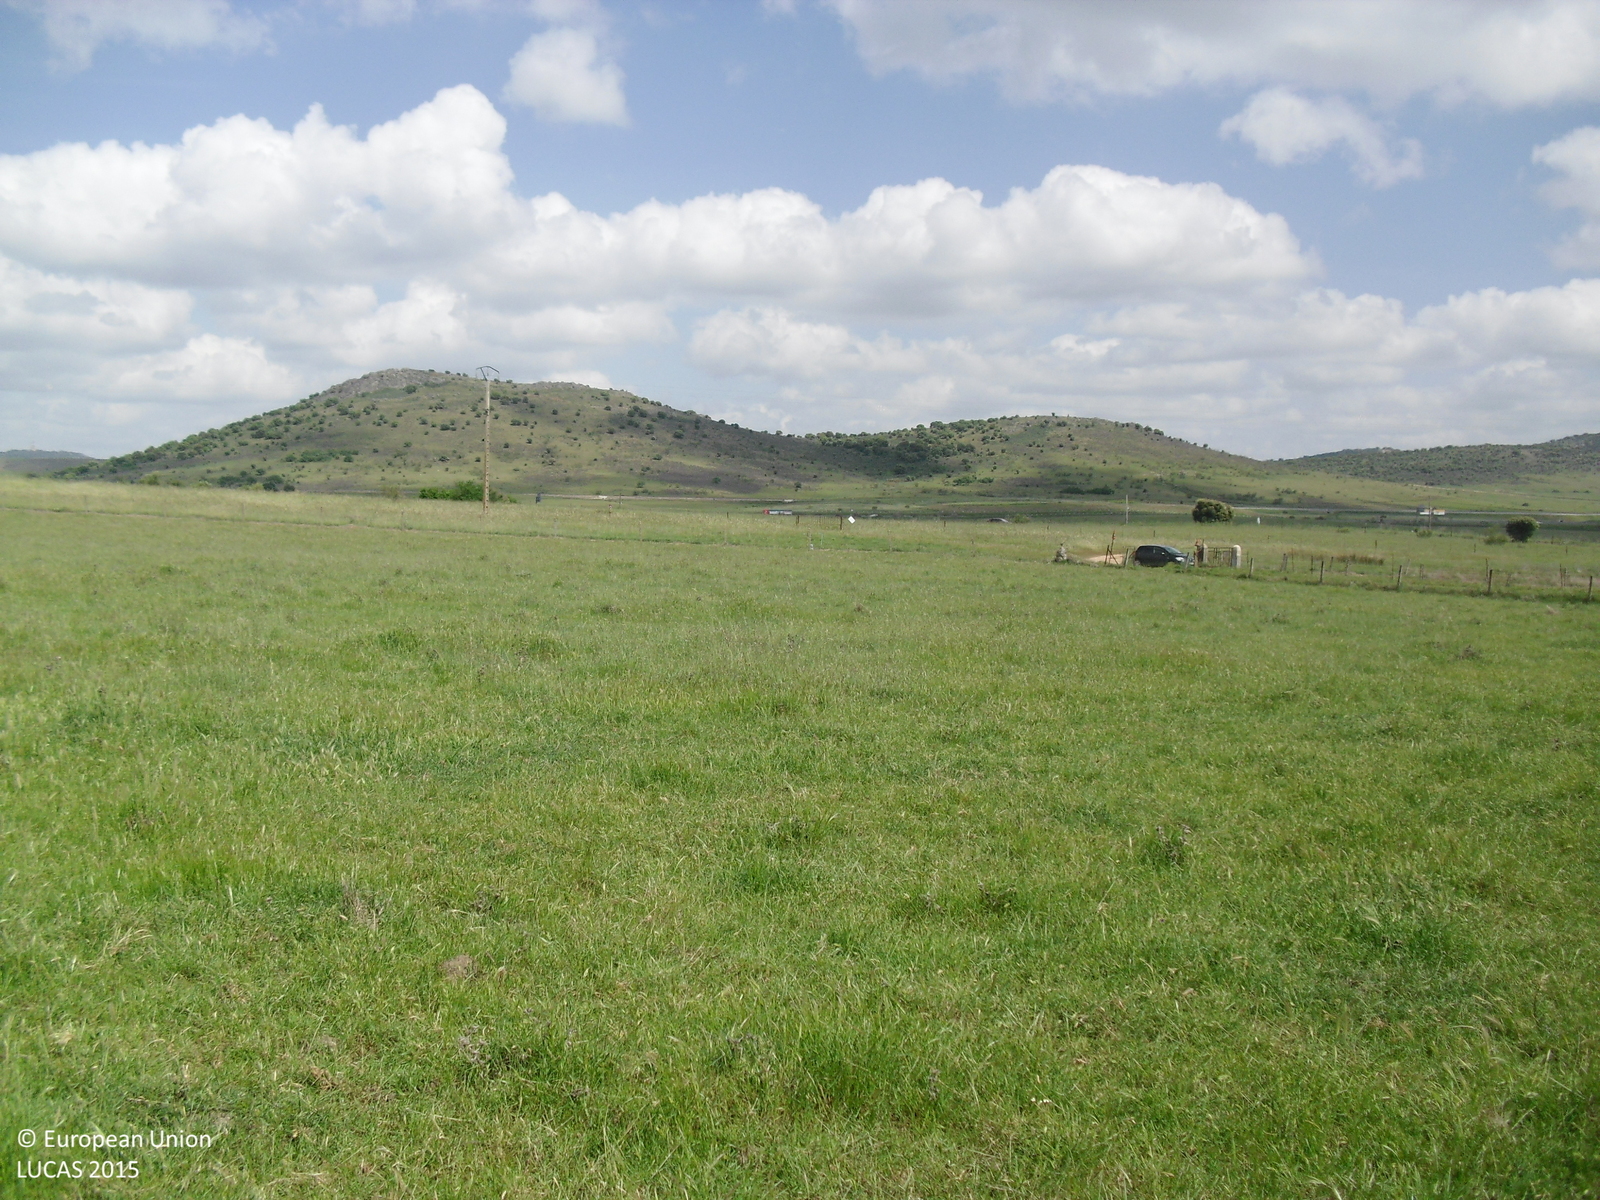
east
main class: Grassland
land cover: Grassland without tree/shrub cover
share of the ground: > 75 %
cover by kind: herbaceous plants 100 %
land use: Agriculture (excluding fallow land and kitchen gardens)
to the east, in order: Grassland without tree/shrub cover; Fences; Tracks; Electric lines; Grassland without tree/shrub cover; Fences; Shruby margins; Paved roads, cycling and walking lanes
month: April
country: ES
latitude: 39.4271
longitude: -6.4128
